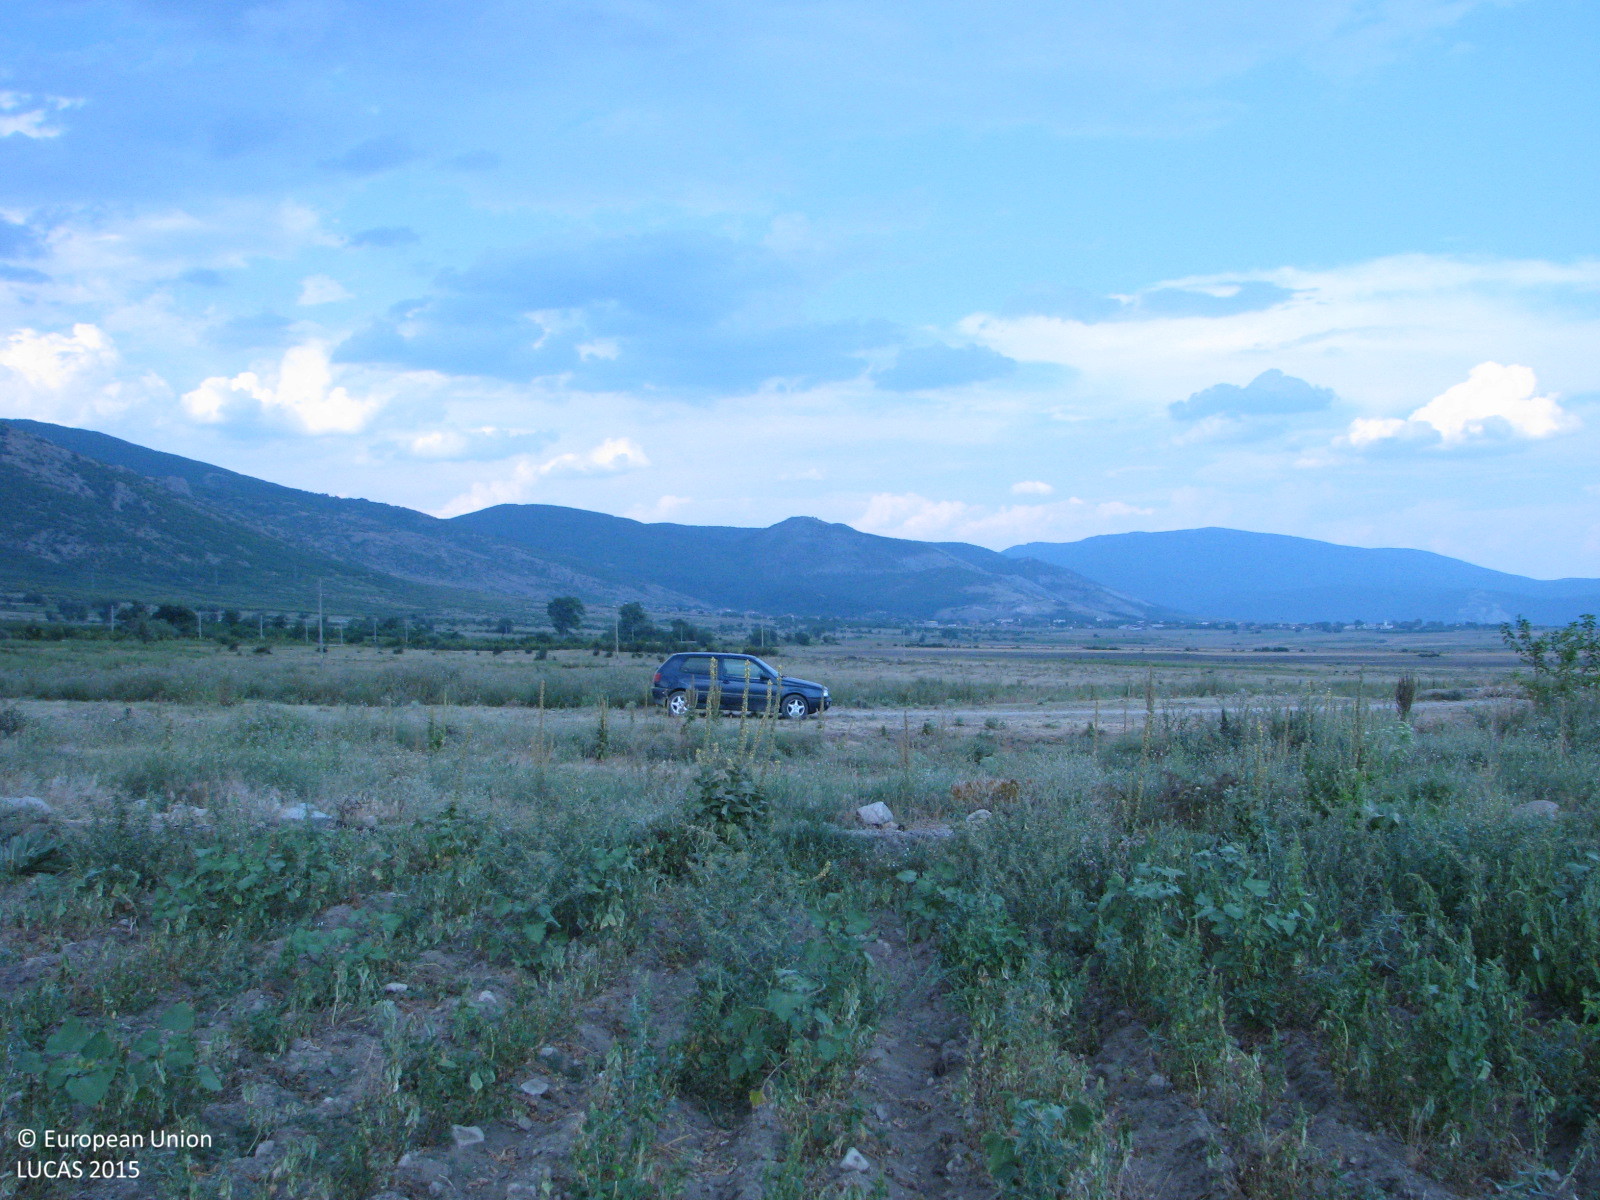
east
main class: Cropland
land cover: Potatoes
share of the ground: 25 - 50 %
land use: Agriculture (excluding fallow land and kitchen gardens)
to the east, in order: Potatoes; Grassland without tree/shrub cover; Ditches and canals; Grass margins; Tracks; Grassland without tree/shrub cover; Ditches and canals; Grassland without tree/shrub cover; Tracks; Grassland without tree/shrub cover
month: July
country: BG
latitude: 42.6795
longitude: 25.9838
